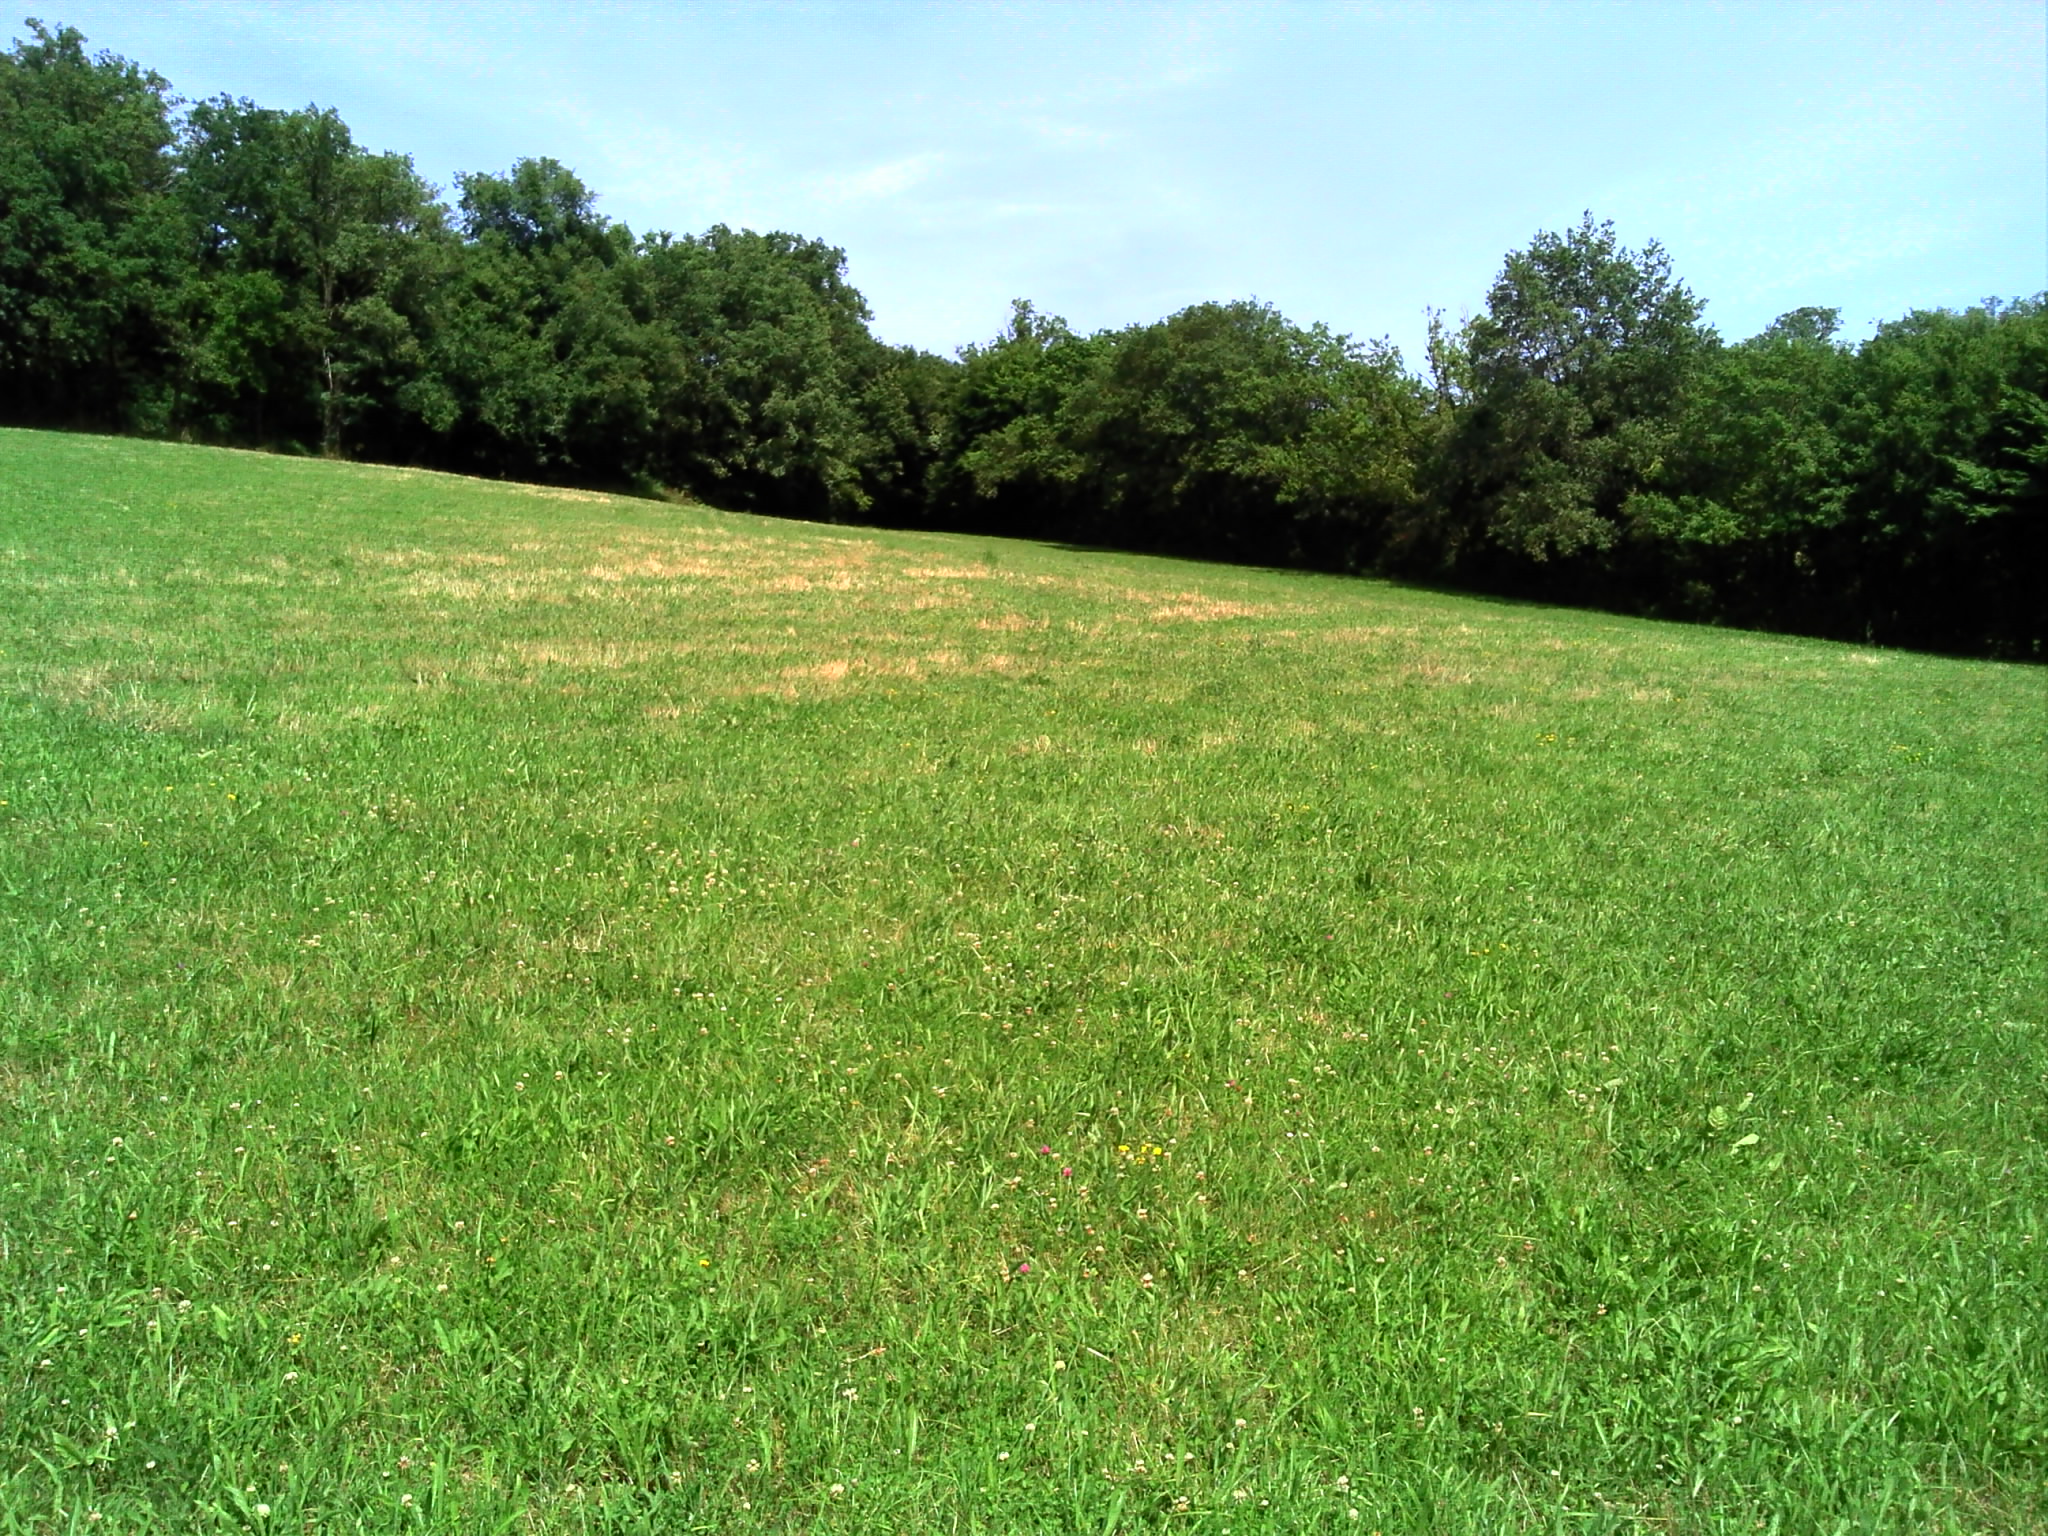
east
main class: Grassland
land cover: Grassland without tree/shrub cover
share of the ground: > 75 %
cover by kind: herbaceous plants 100 %
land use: Agriculture (excluding fallow land and kitchen gardens)
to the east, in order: Grassland without tree/shrub cover; Fences; Broadleaved woodland; Grassland without tree/shrub cover; Broadleaved woodland; Dry stone walls; Fences; Broadleaved woodland; Grassland without tree/shrub cover; Single bushes/trees; Grassland without tree/shrub cover; Ditches and canals; Grassland without tree/shrub cover
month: June
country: FR
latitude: 44.8201
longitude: 1.7652
